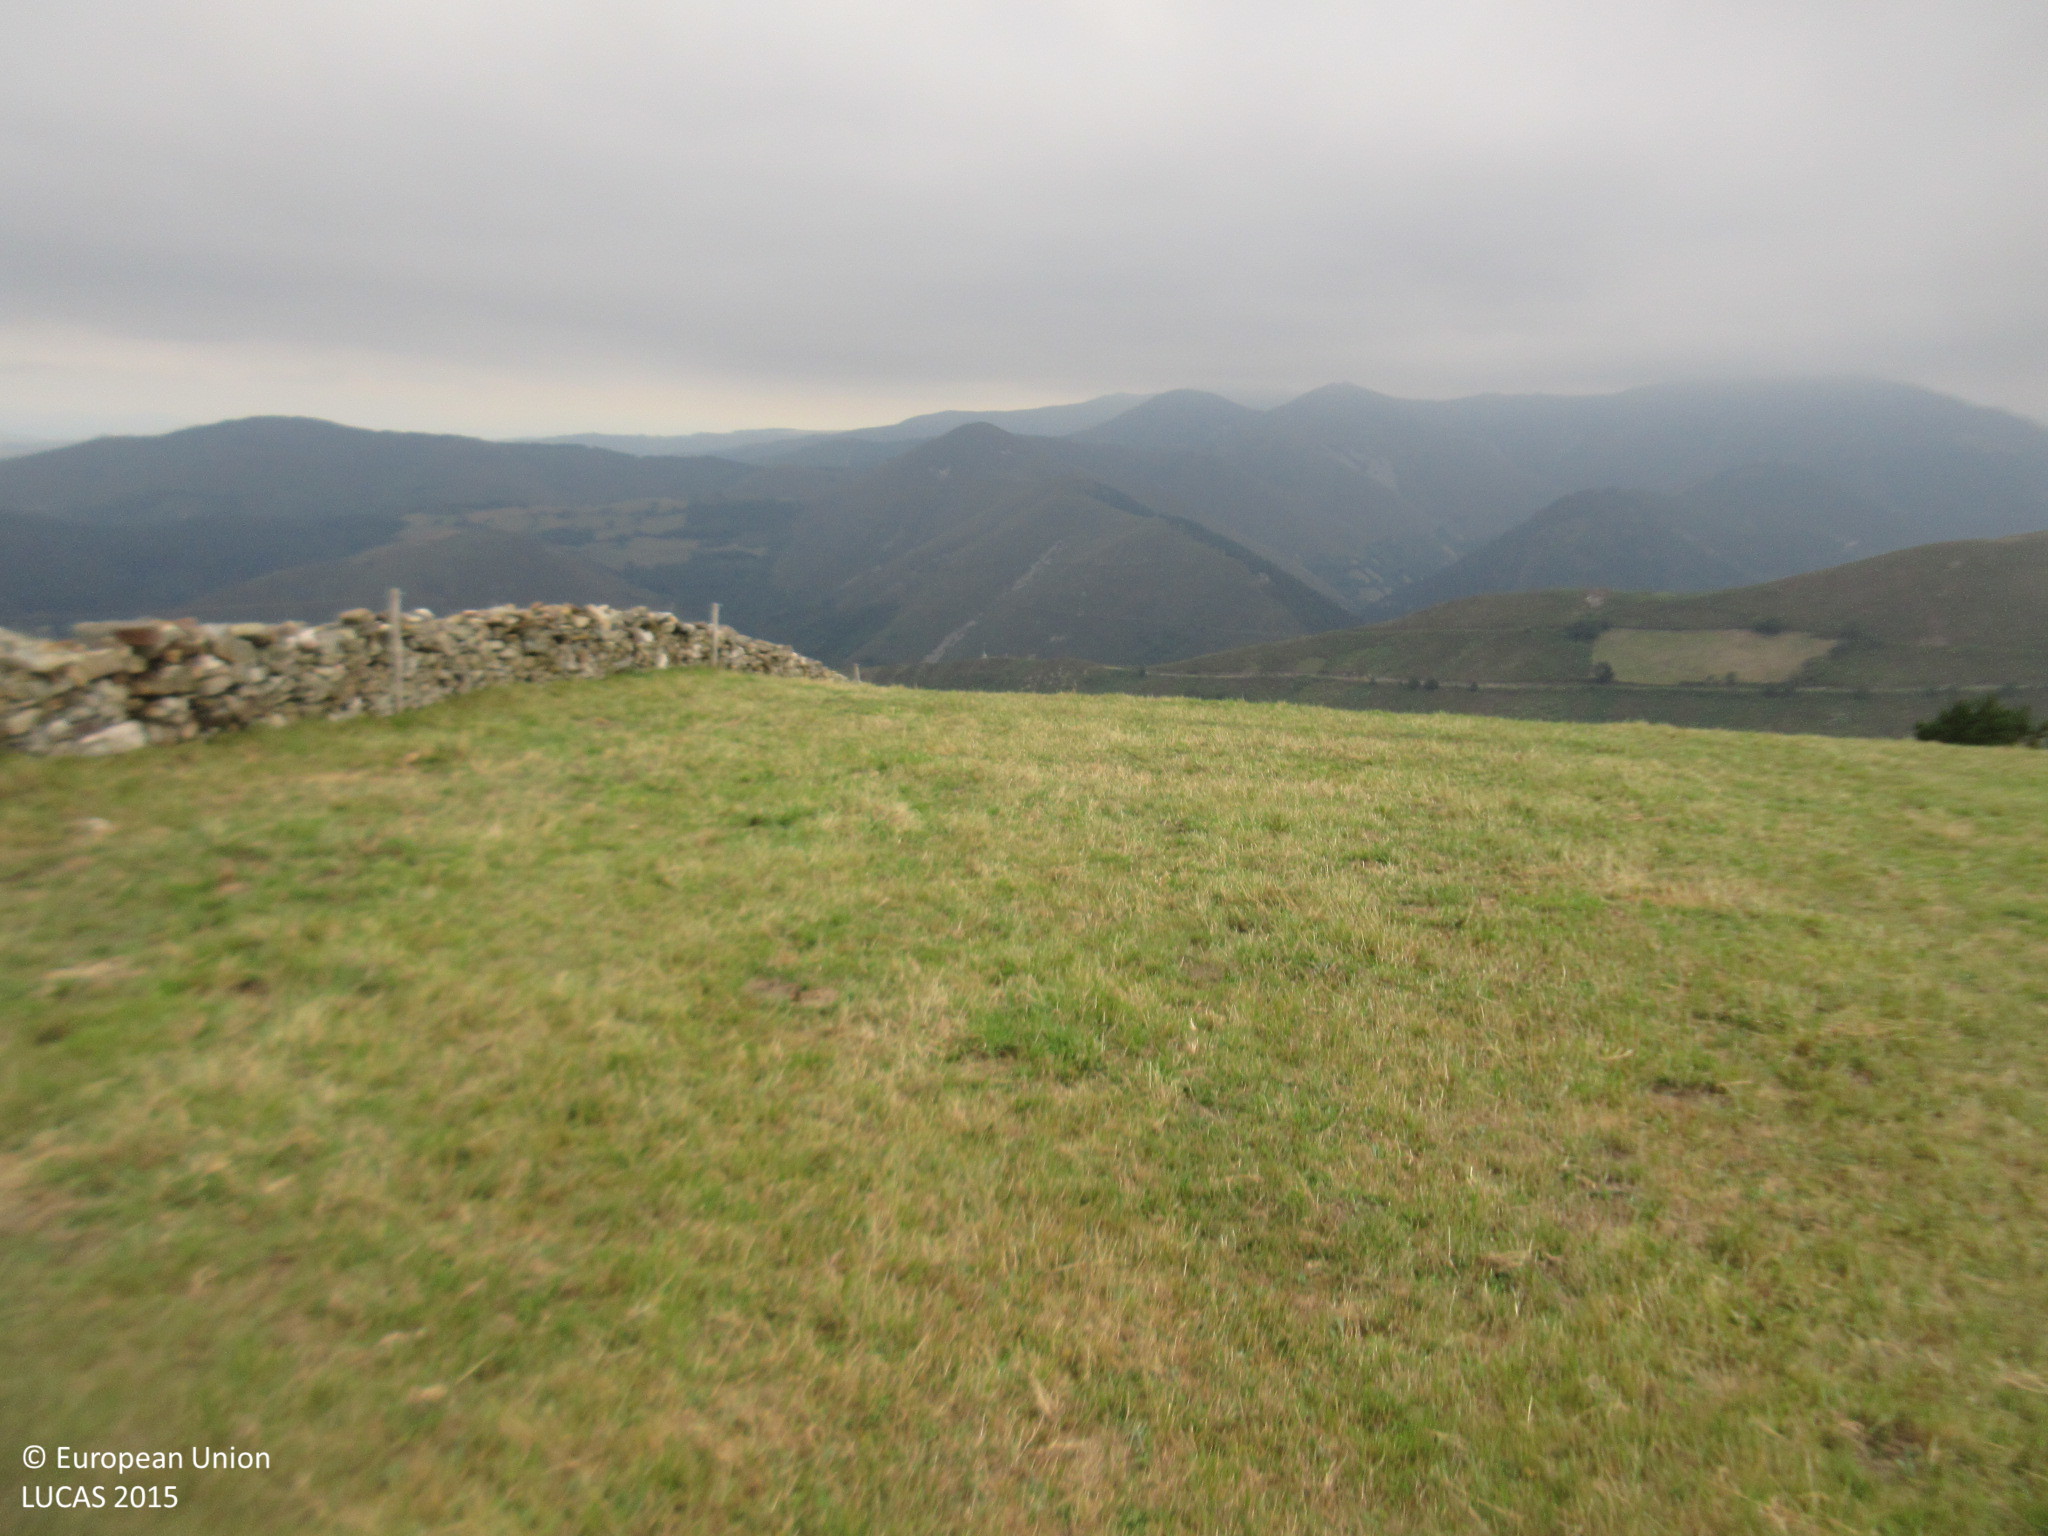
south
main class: Grassland
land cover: Grassland without tree/shrub cover
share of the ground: > 75 %
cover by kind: herbaceous plants 100 %
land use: Agriculture (excluding fallow land and kitchen gardens)
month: August
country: ES
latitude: 43.4256
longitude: -6.5965
